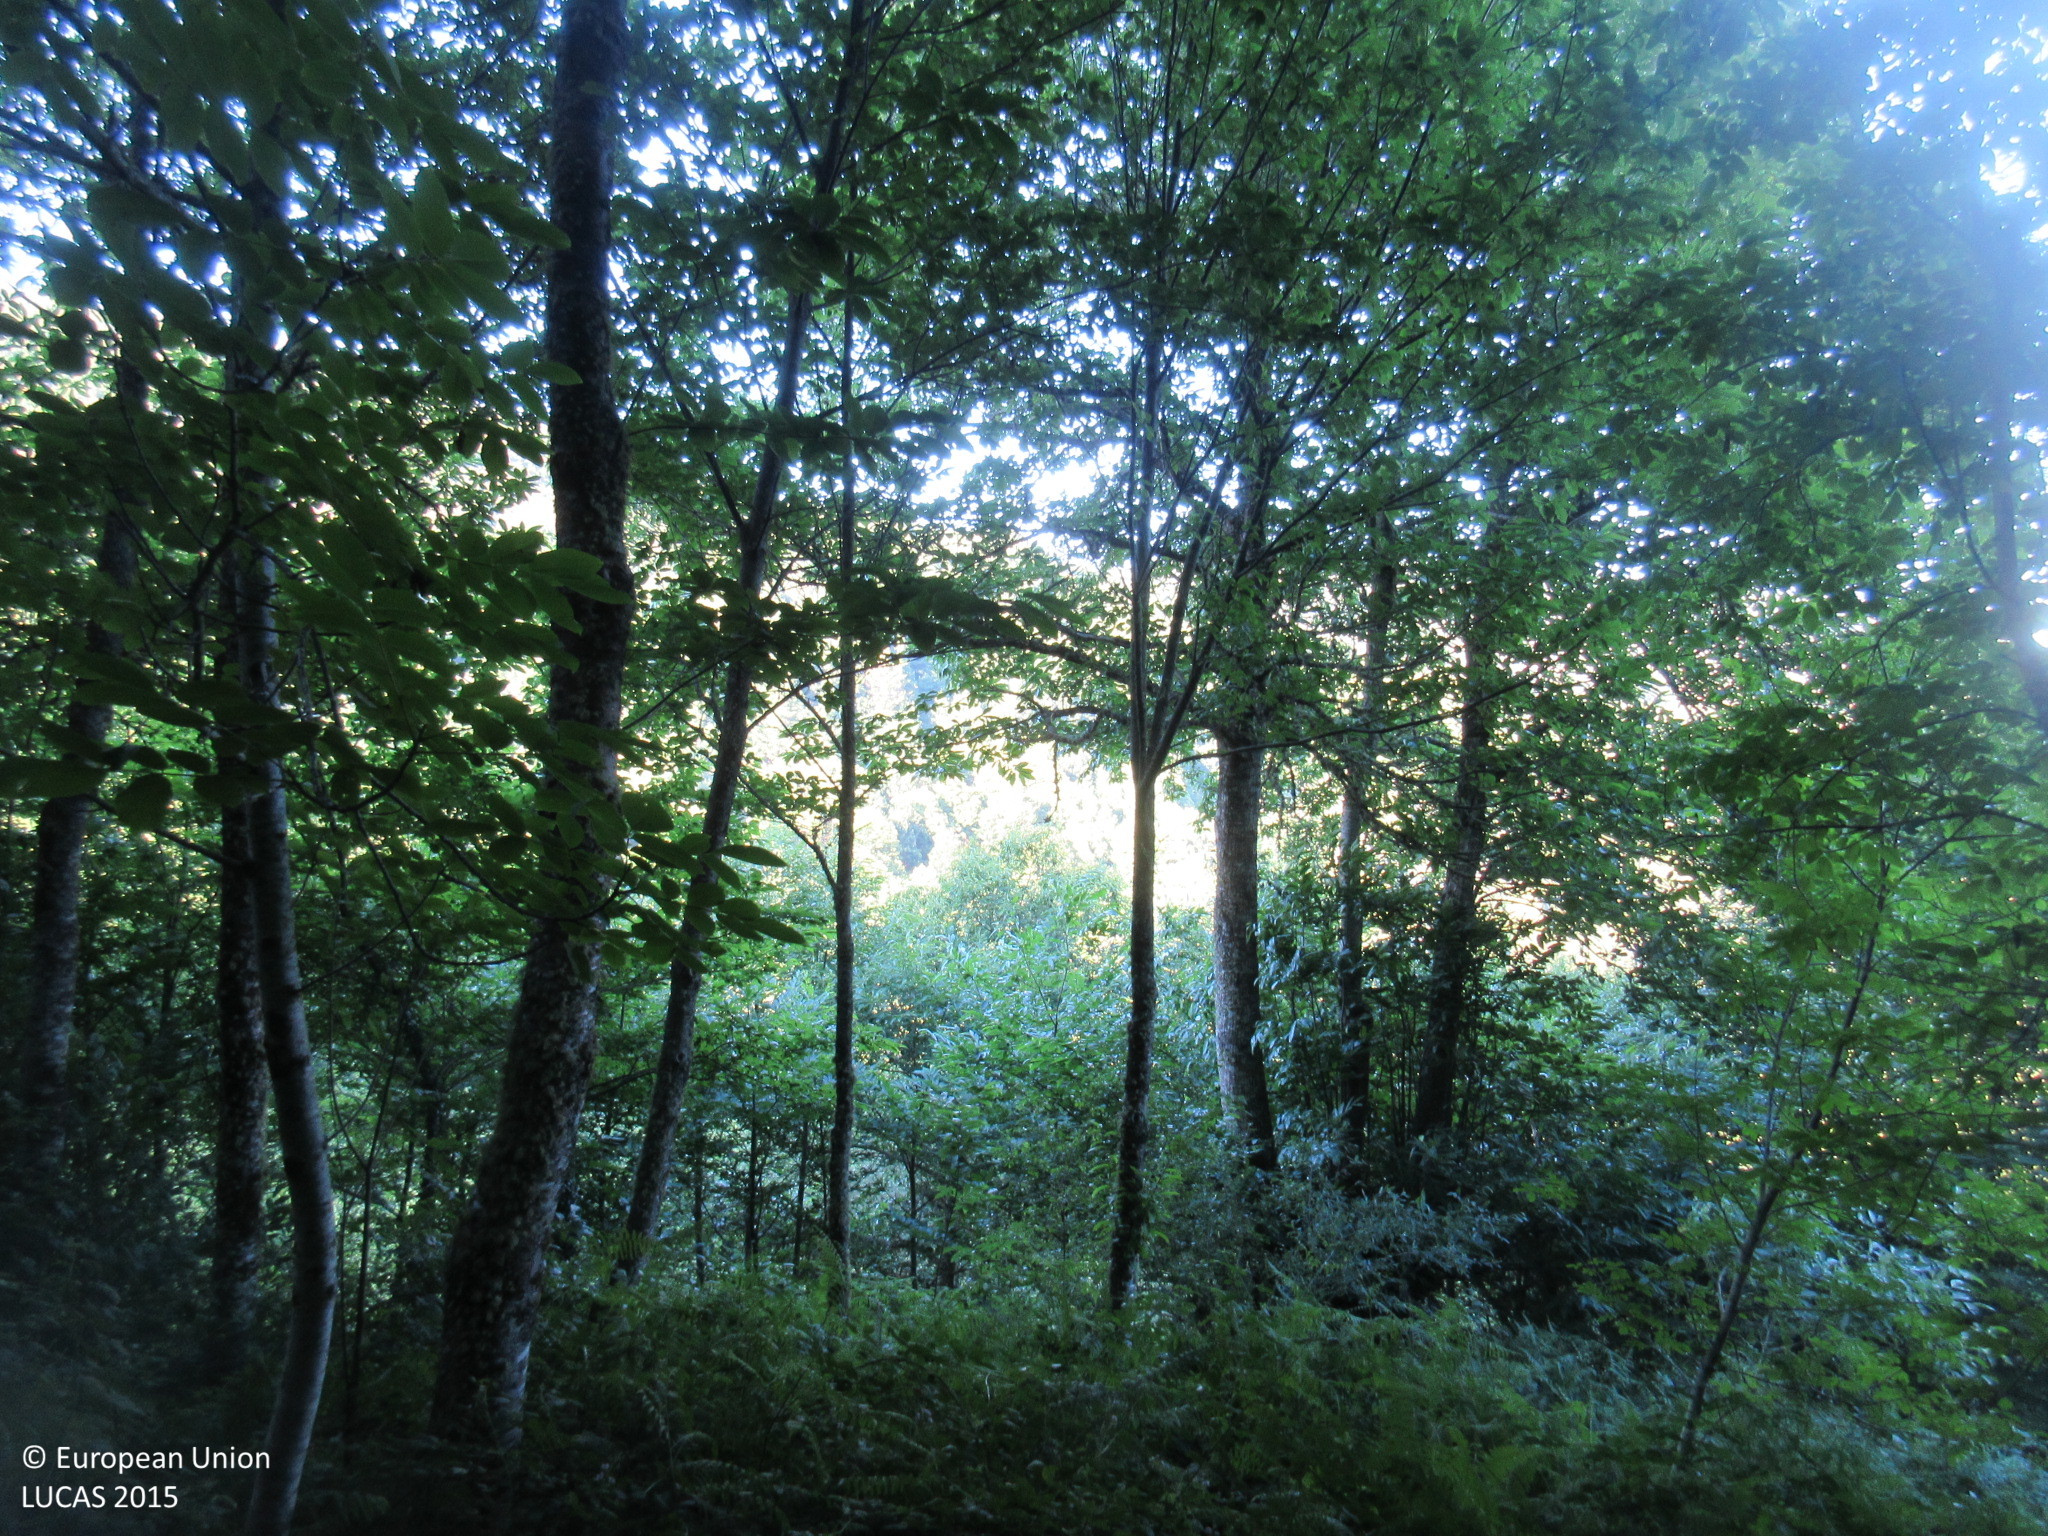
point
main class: Woodland
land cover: Broadleaved woodland
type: acidophilous oak and oak-birch forest
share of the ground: > 75 %
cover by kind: broadleaved forest trees 100 %
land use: Semi-natural and natural areas not in use
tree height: > 5 m
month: June
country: ES
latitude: 43.0875
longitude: -7.0788
